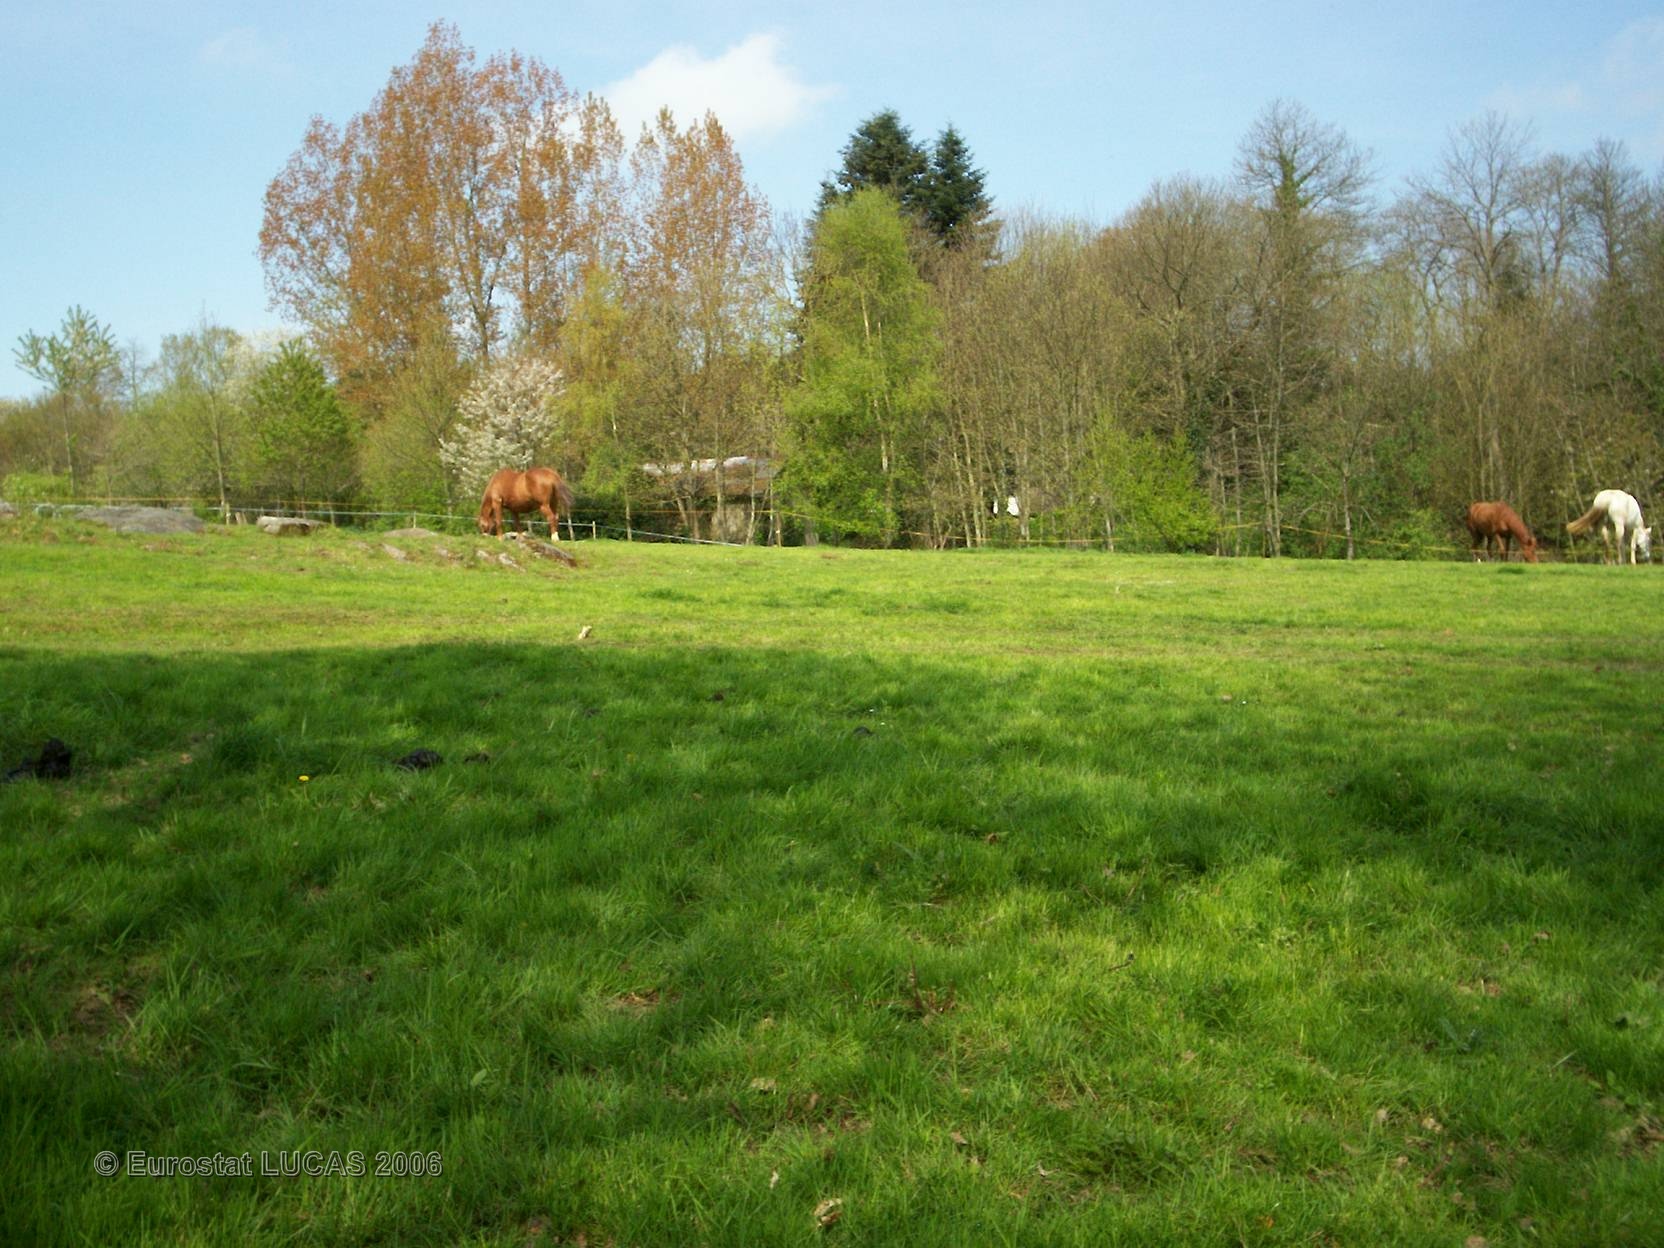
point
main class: Grassland
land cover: Grassland without tree/shrub cover
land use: Agriculture (excluding fallow land and kitchen gardens)
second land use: Sport
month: May
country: FR
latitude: 48.2768
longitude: -2.4705
